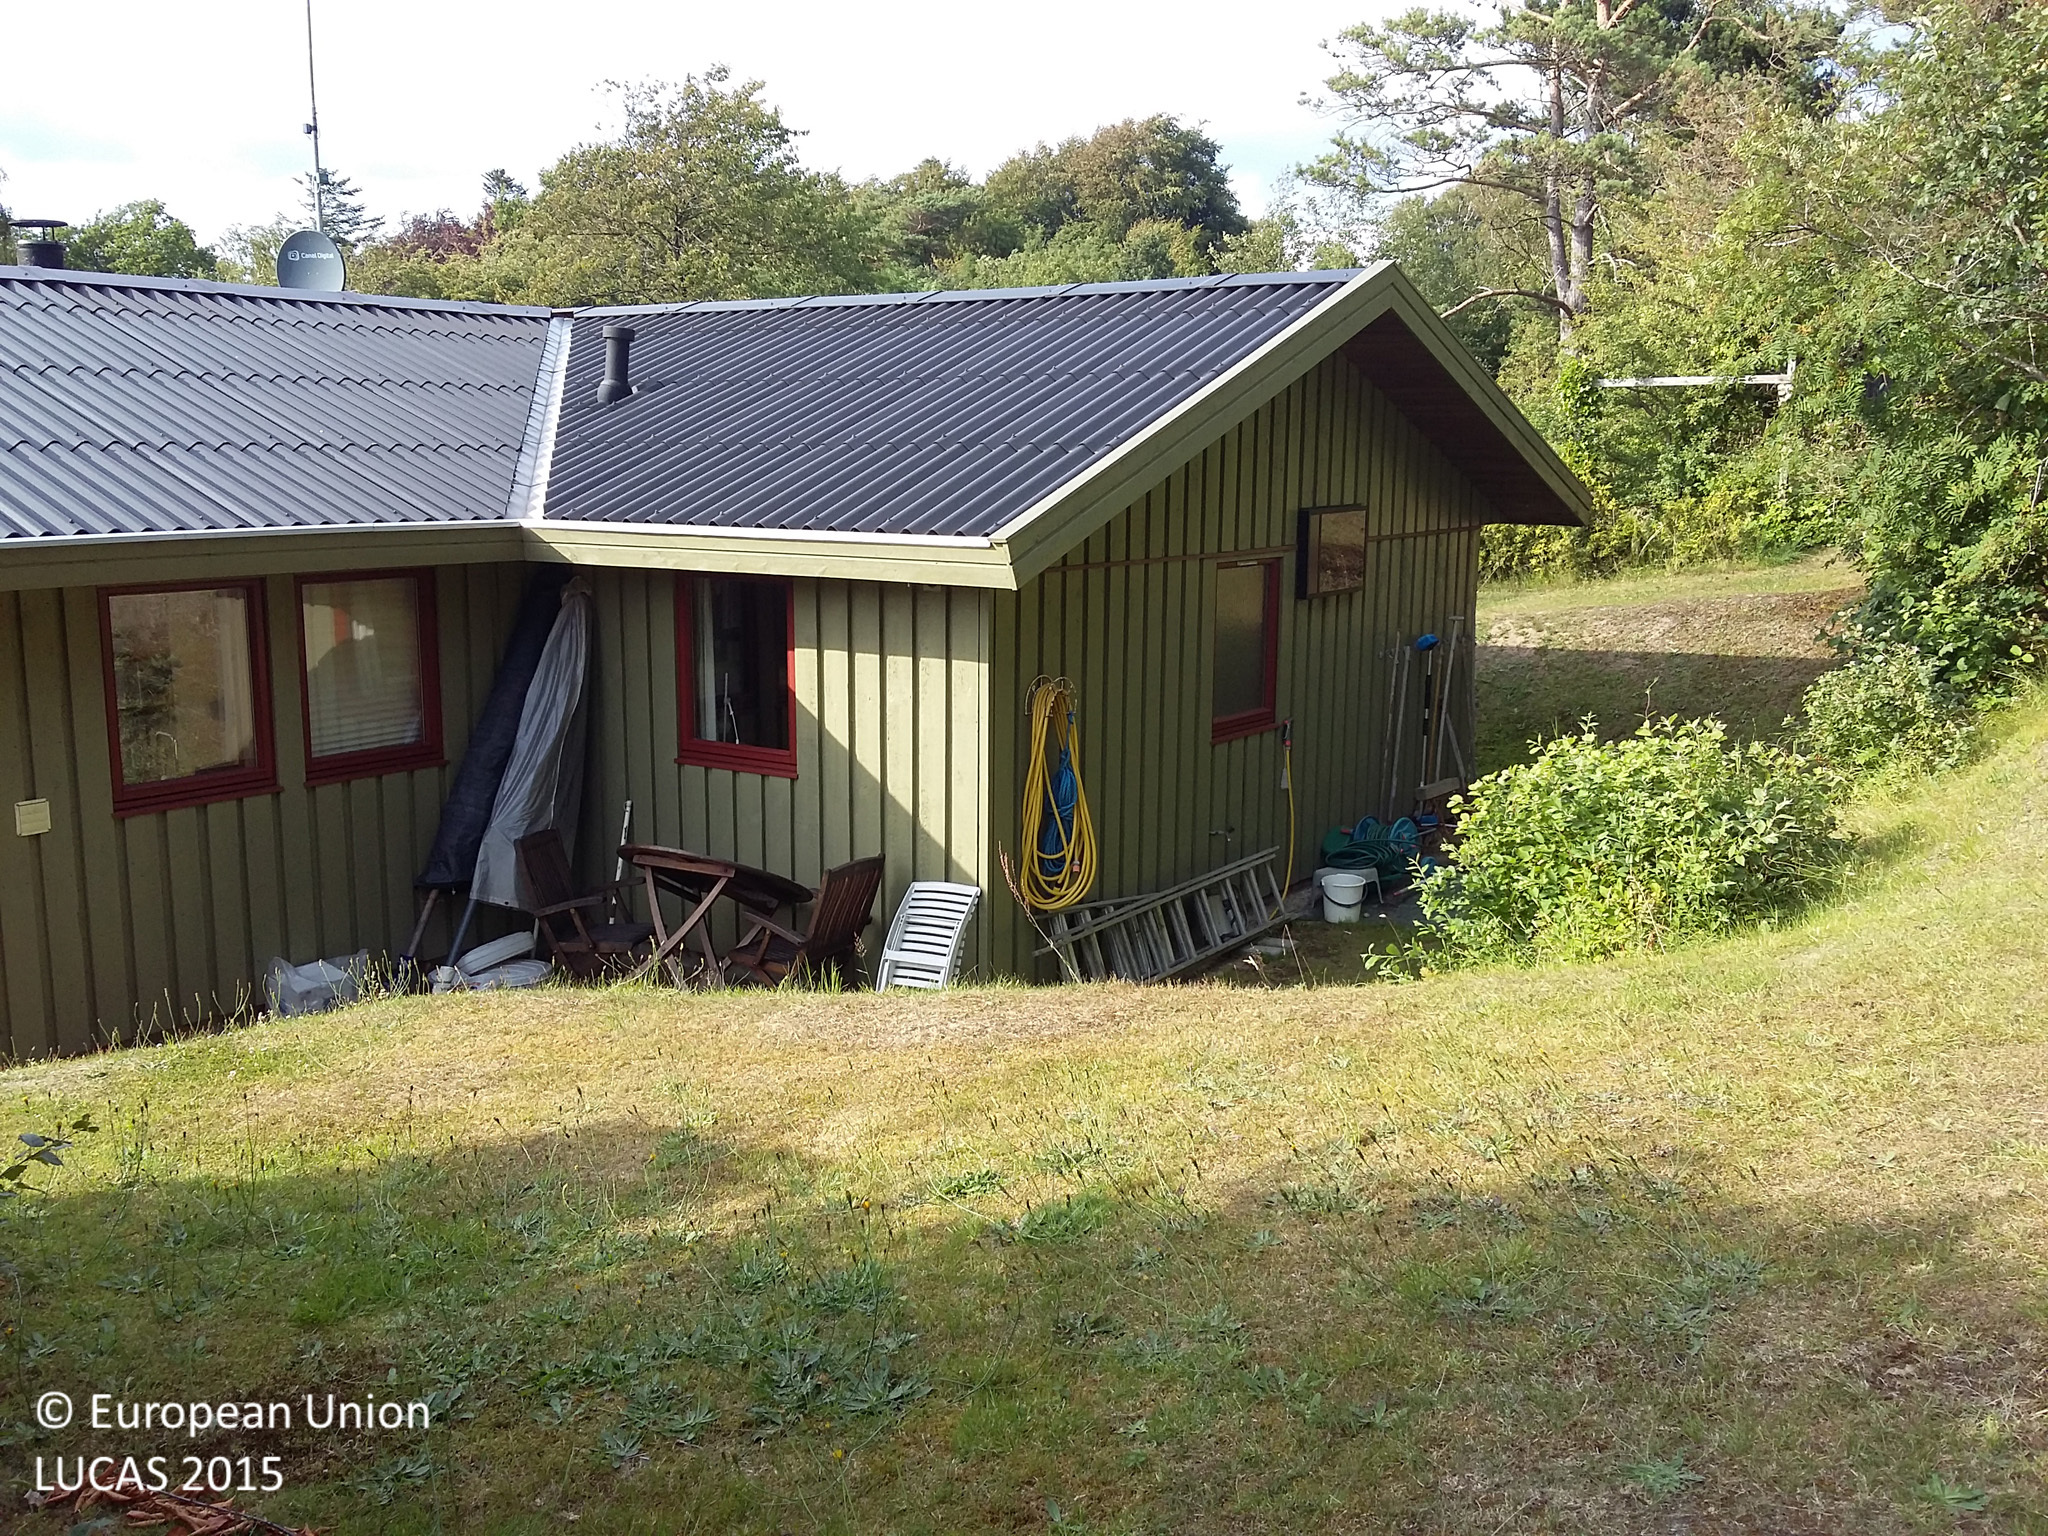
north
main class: Woodland
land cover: Broadleaved woodland
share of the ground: > 75 %
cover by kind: broadleaved forest trees 80 %, herbaceous plants 20 %
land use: Residential
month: July
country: DK
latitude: 56.0975
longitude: 12.1680
